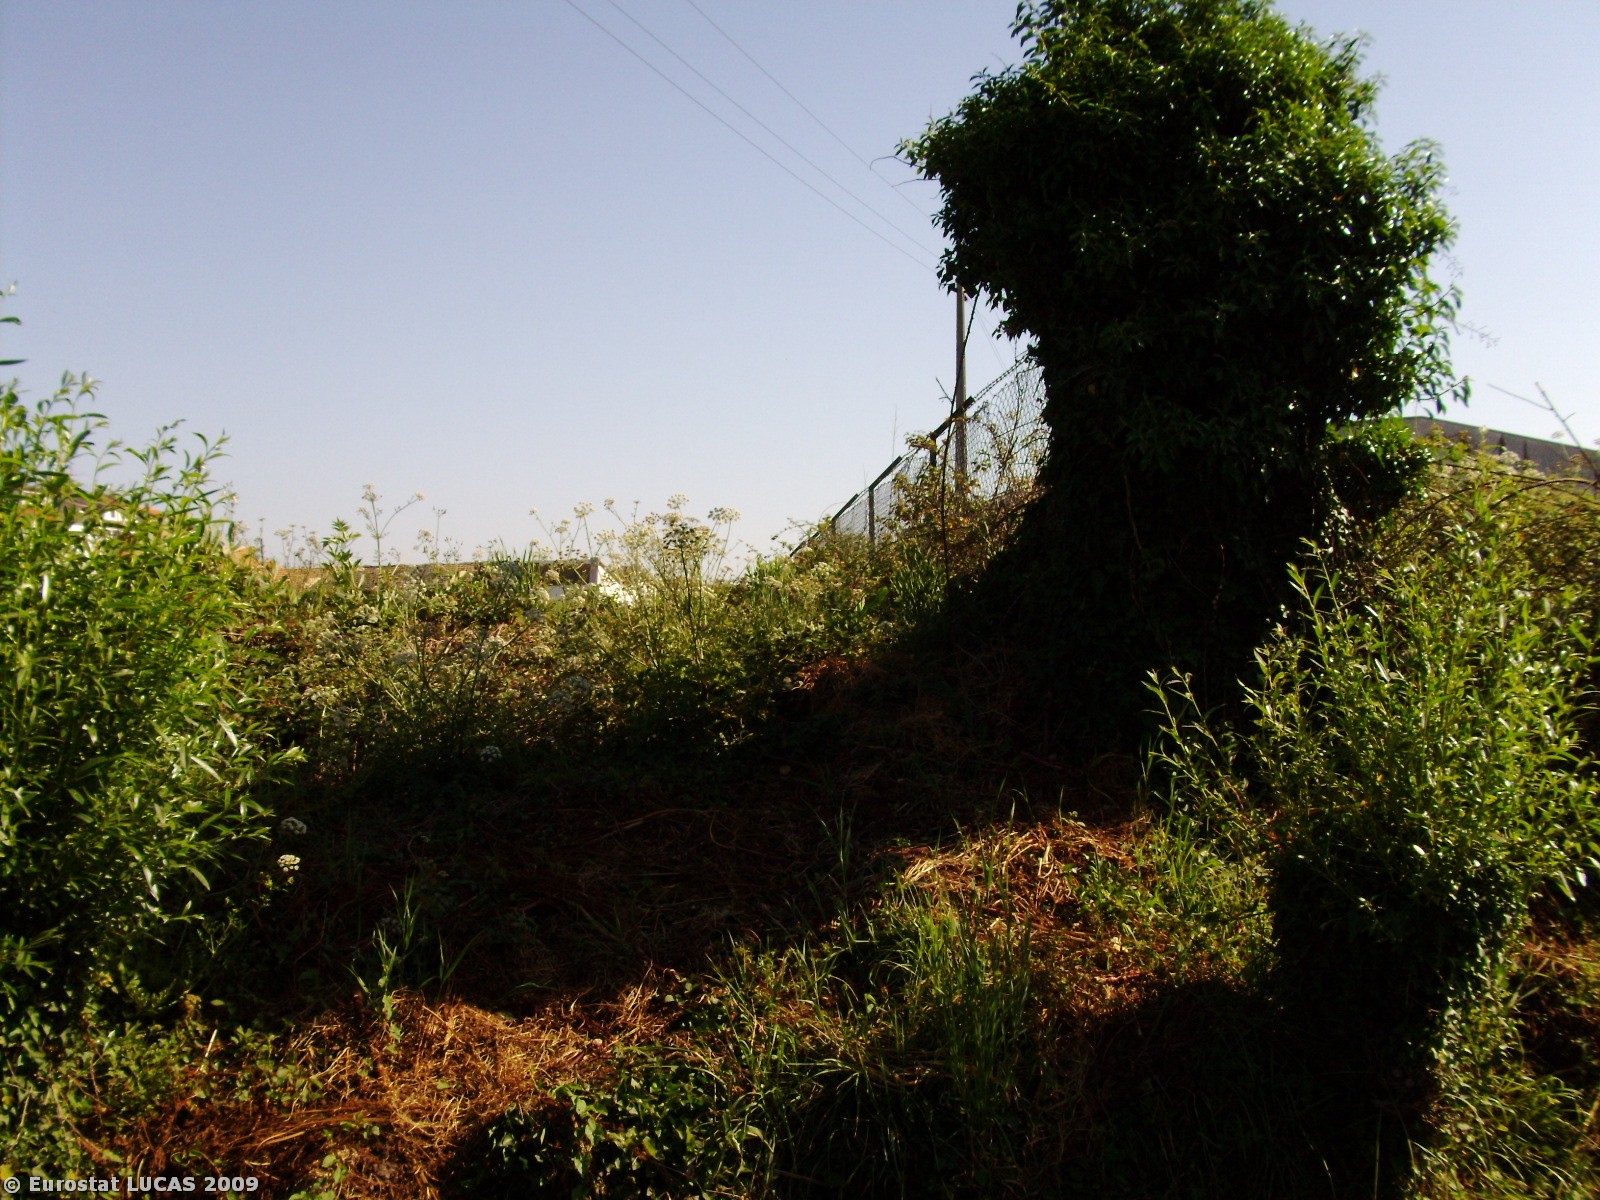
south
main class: Grassland
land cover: Spontaneously vegetated surfaces
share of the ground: > 75 %
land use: Fallow land
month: May
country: PT
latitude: 40.5746
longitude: -8.4355
